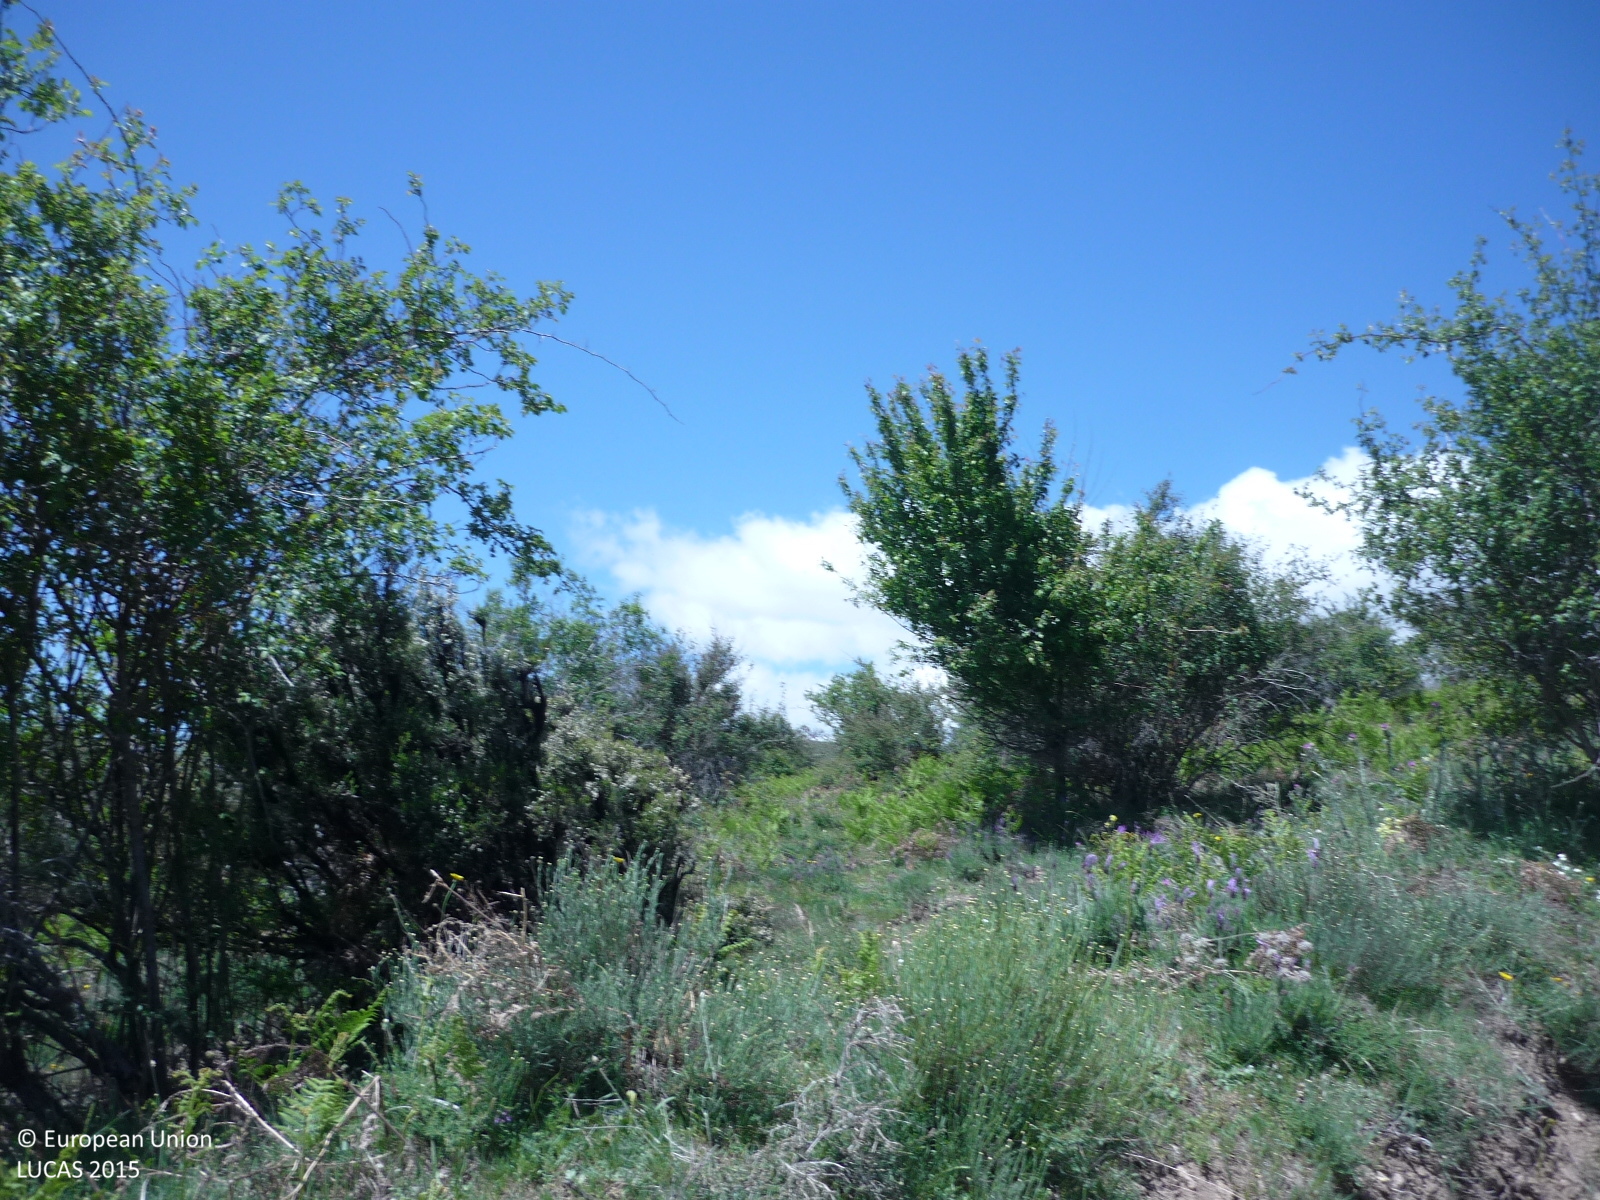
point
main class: Grassland
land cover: Grassland without tree/shrub cover
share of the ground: > 75 %
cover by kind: herbaceous plants 90 %, unconsolidated bare surface 10 %
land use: Agriculture (excluding fallow land and kitchen gardens)
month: May
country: ES
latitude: 41.1007
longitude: -3.5340
